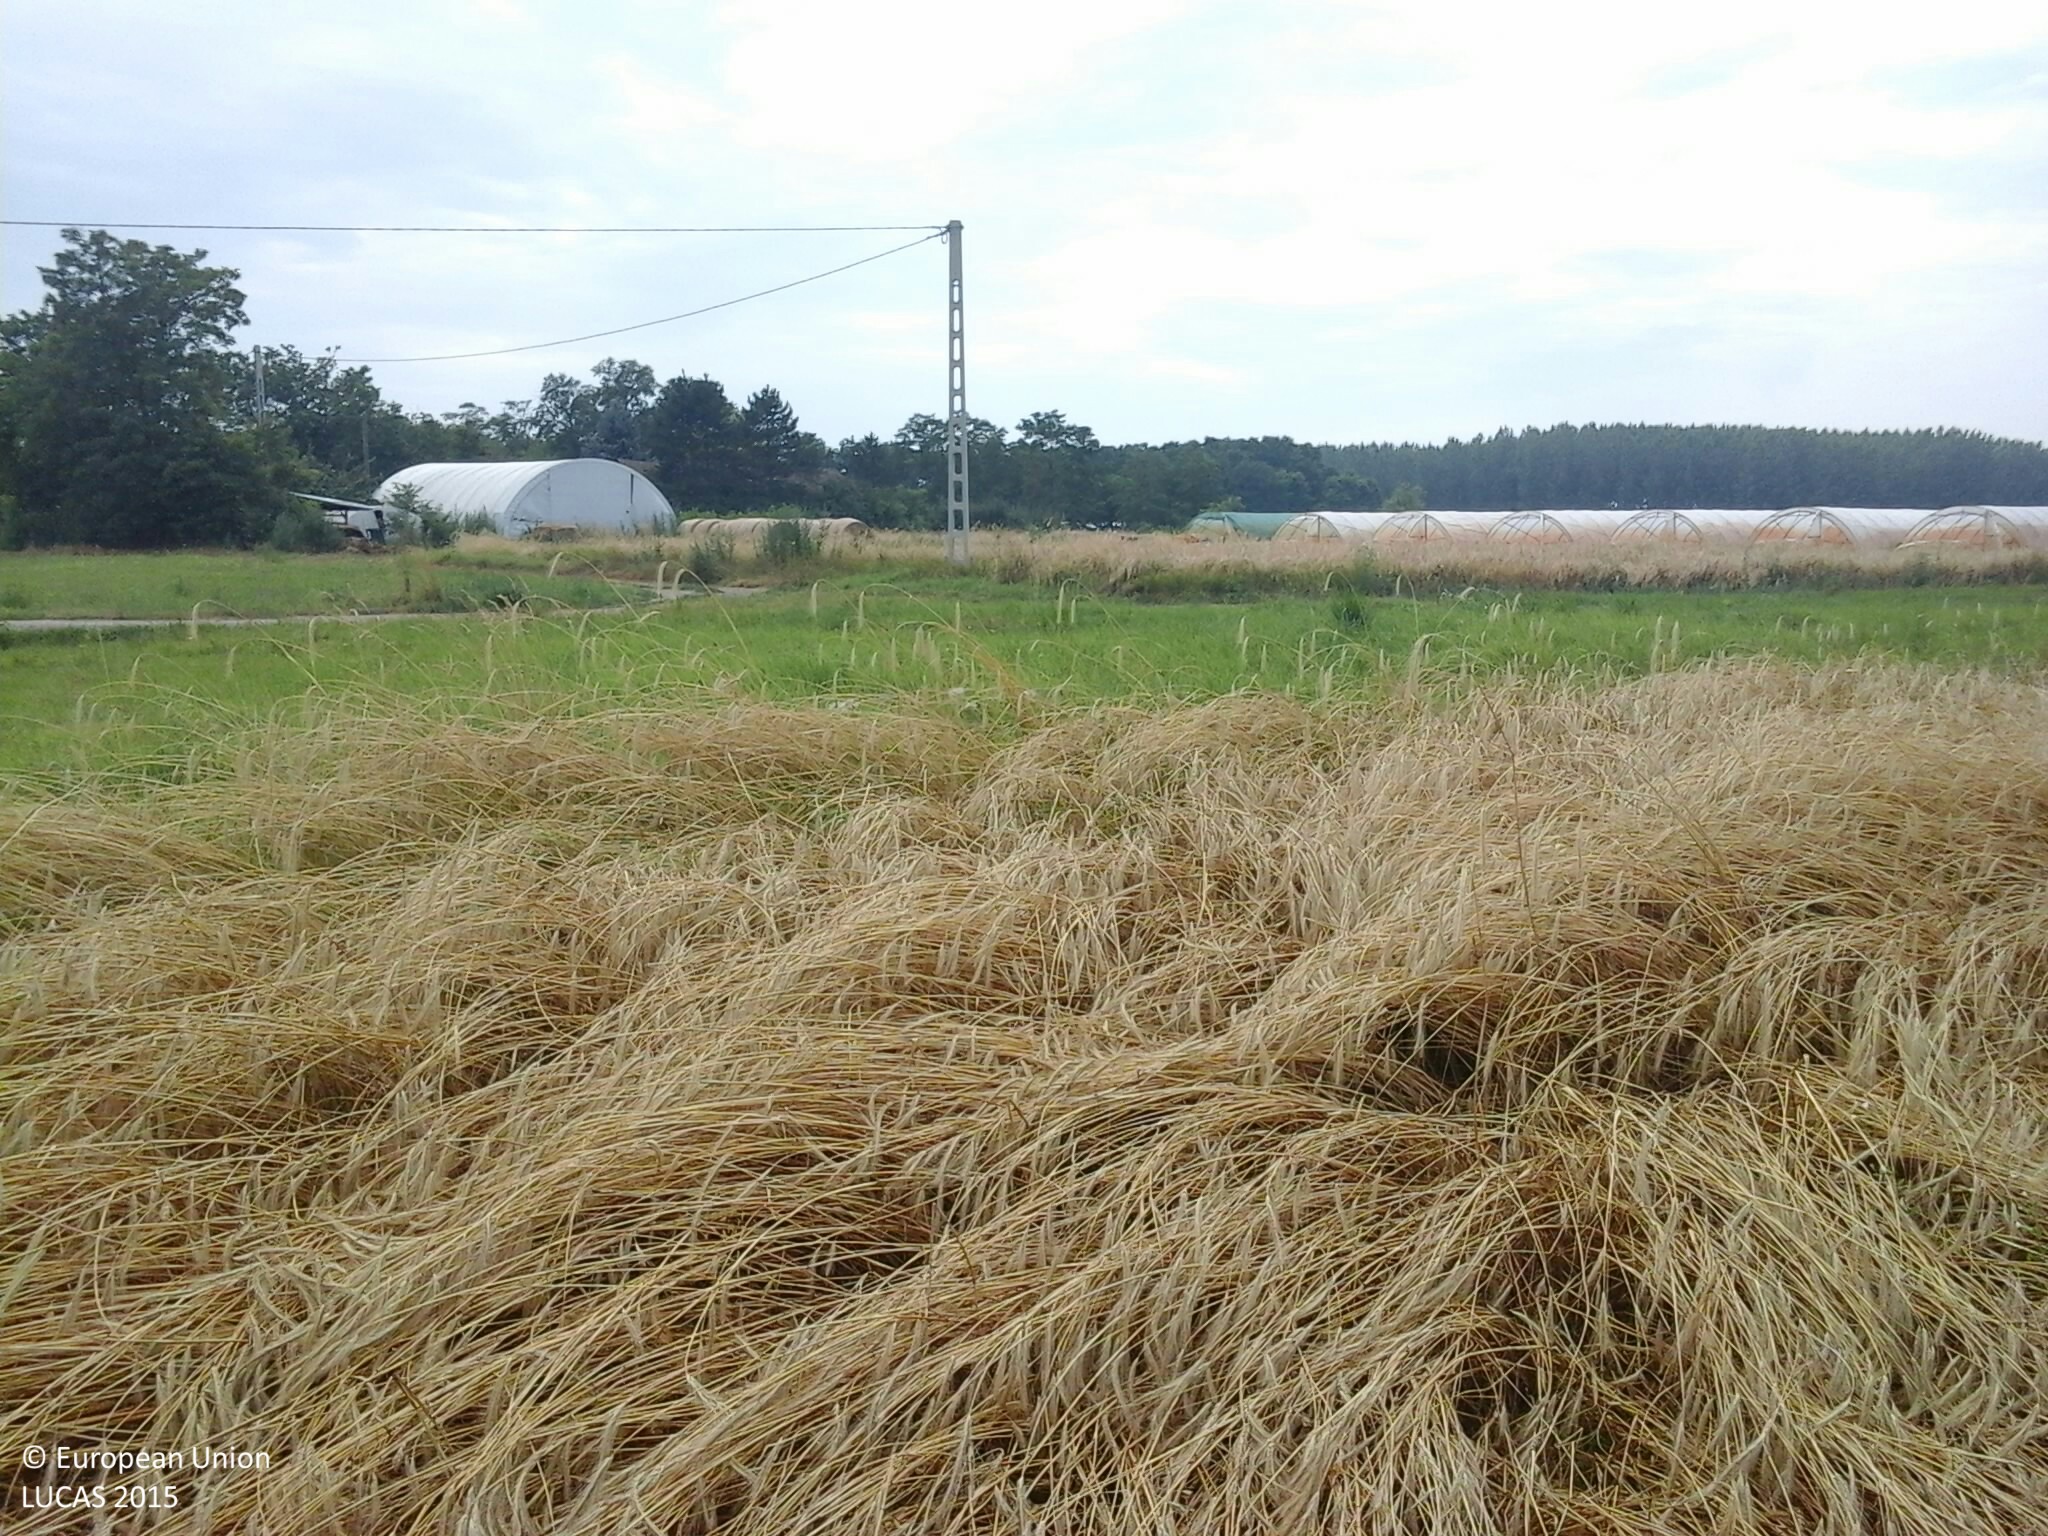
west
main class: Cropland
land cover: Triticale
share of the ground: > 75 %
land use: Agriculture (excluding fallow land and kitchen gardens)
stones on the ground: < 10 %
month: July
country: HU
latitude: 46.4409
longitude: 20.0312
